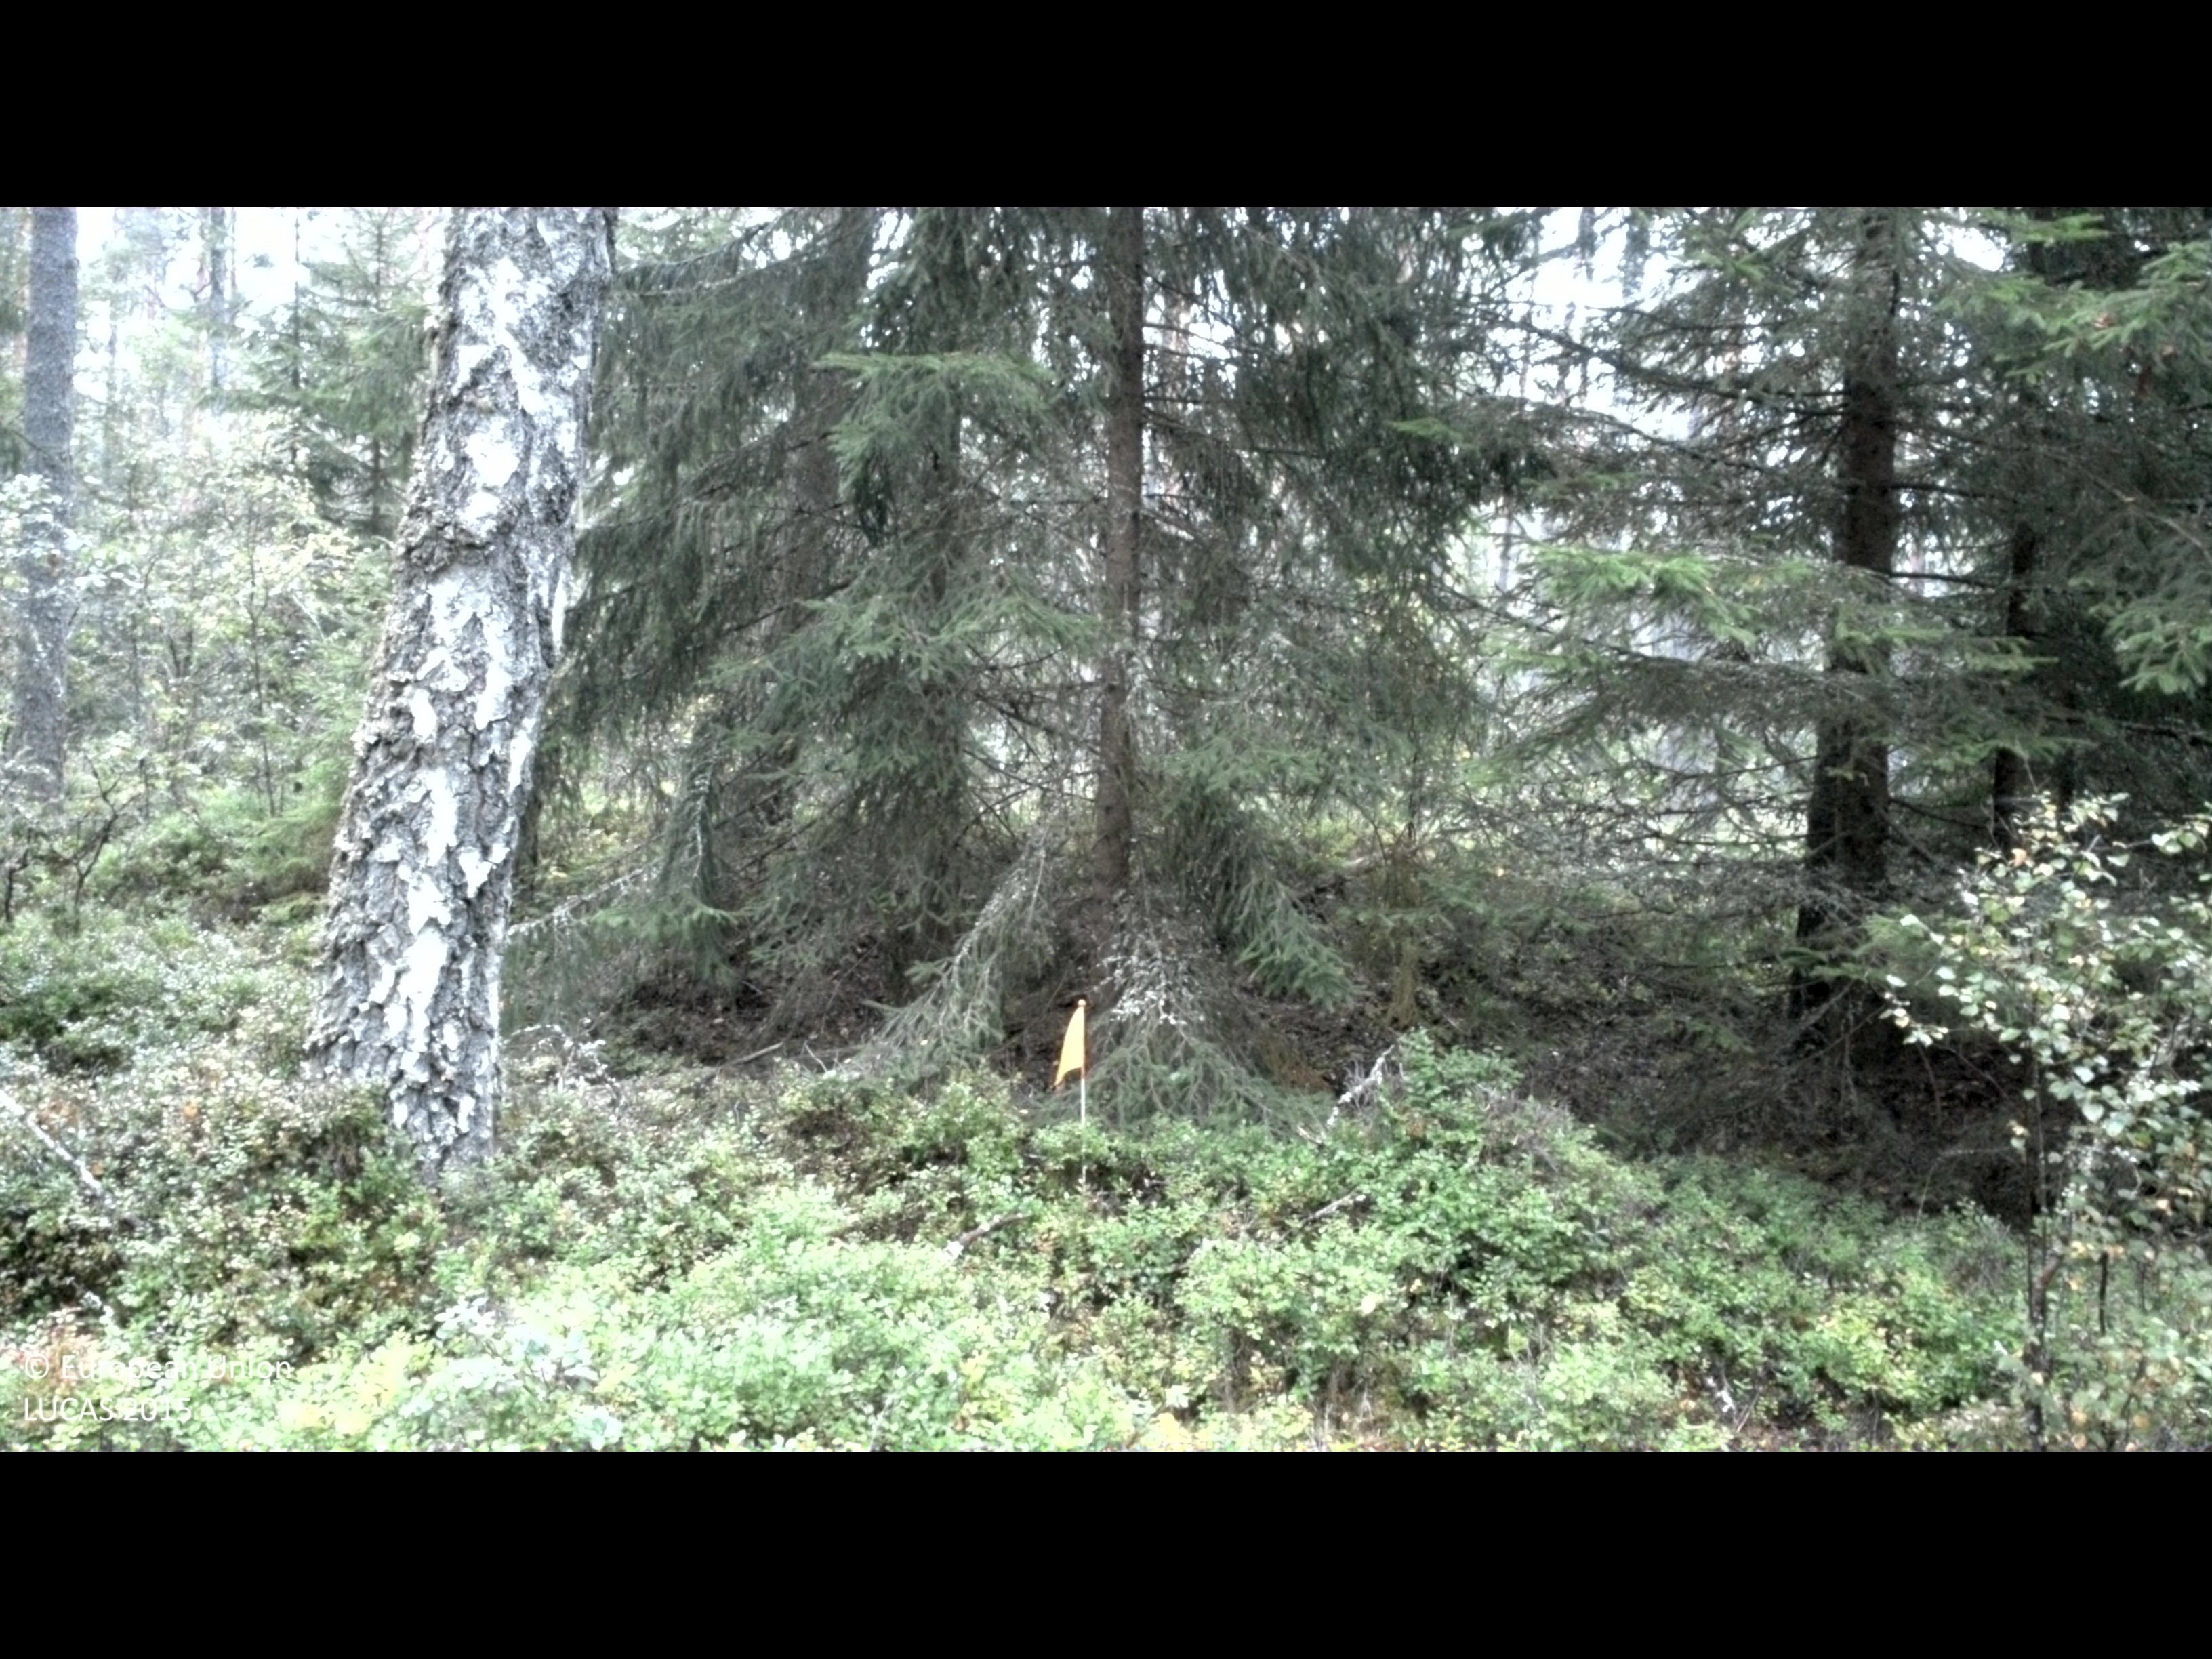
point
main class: Woodland
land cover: Spruce dominated coniferous woodland
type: boreal forest
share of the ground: 50 - 75 %
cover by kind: coniferous forest trees 60 %, shrubs 30 %, broadleaved forest trees 10 %
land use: Forestry
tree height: > 5 m
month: August
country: SE
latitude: 57.3347
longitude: 13.8996
